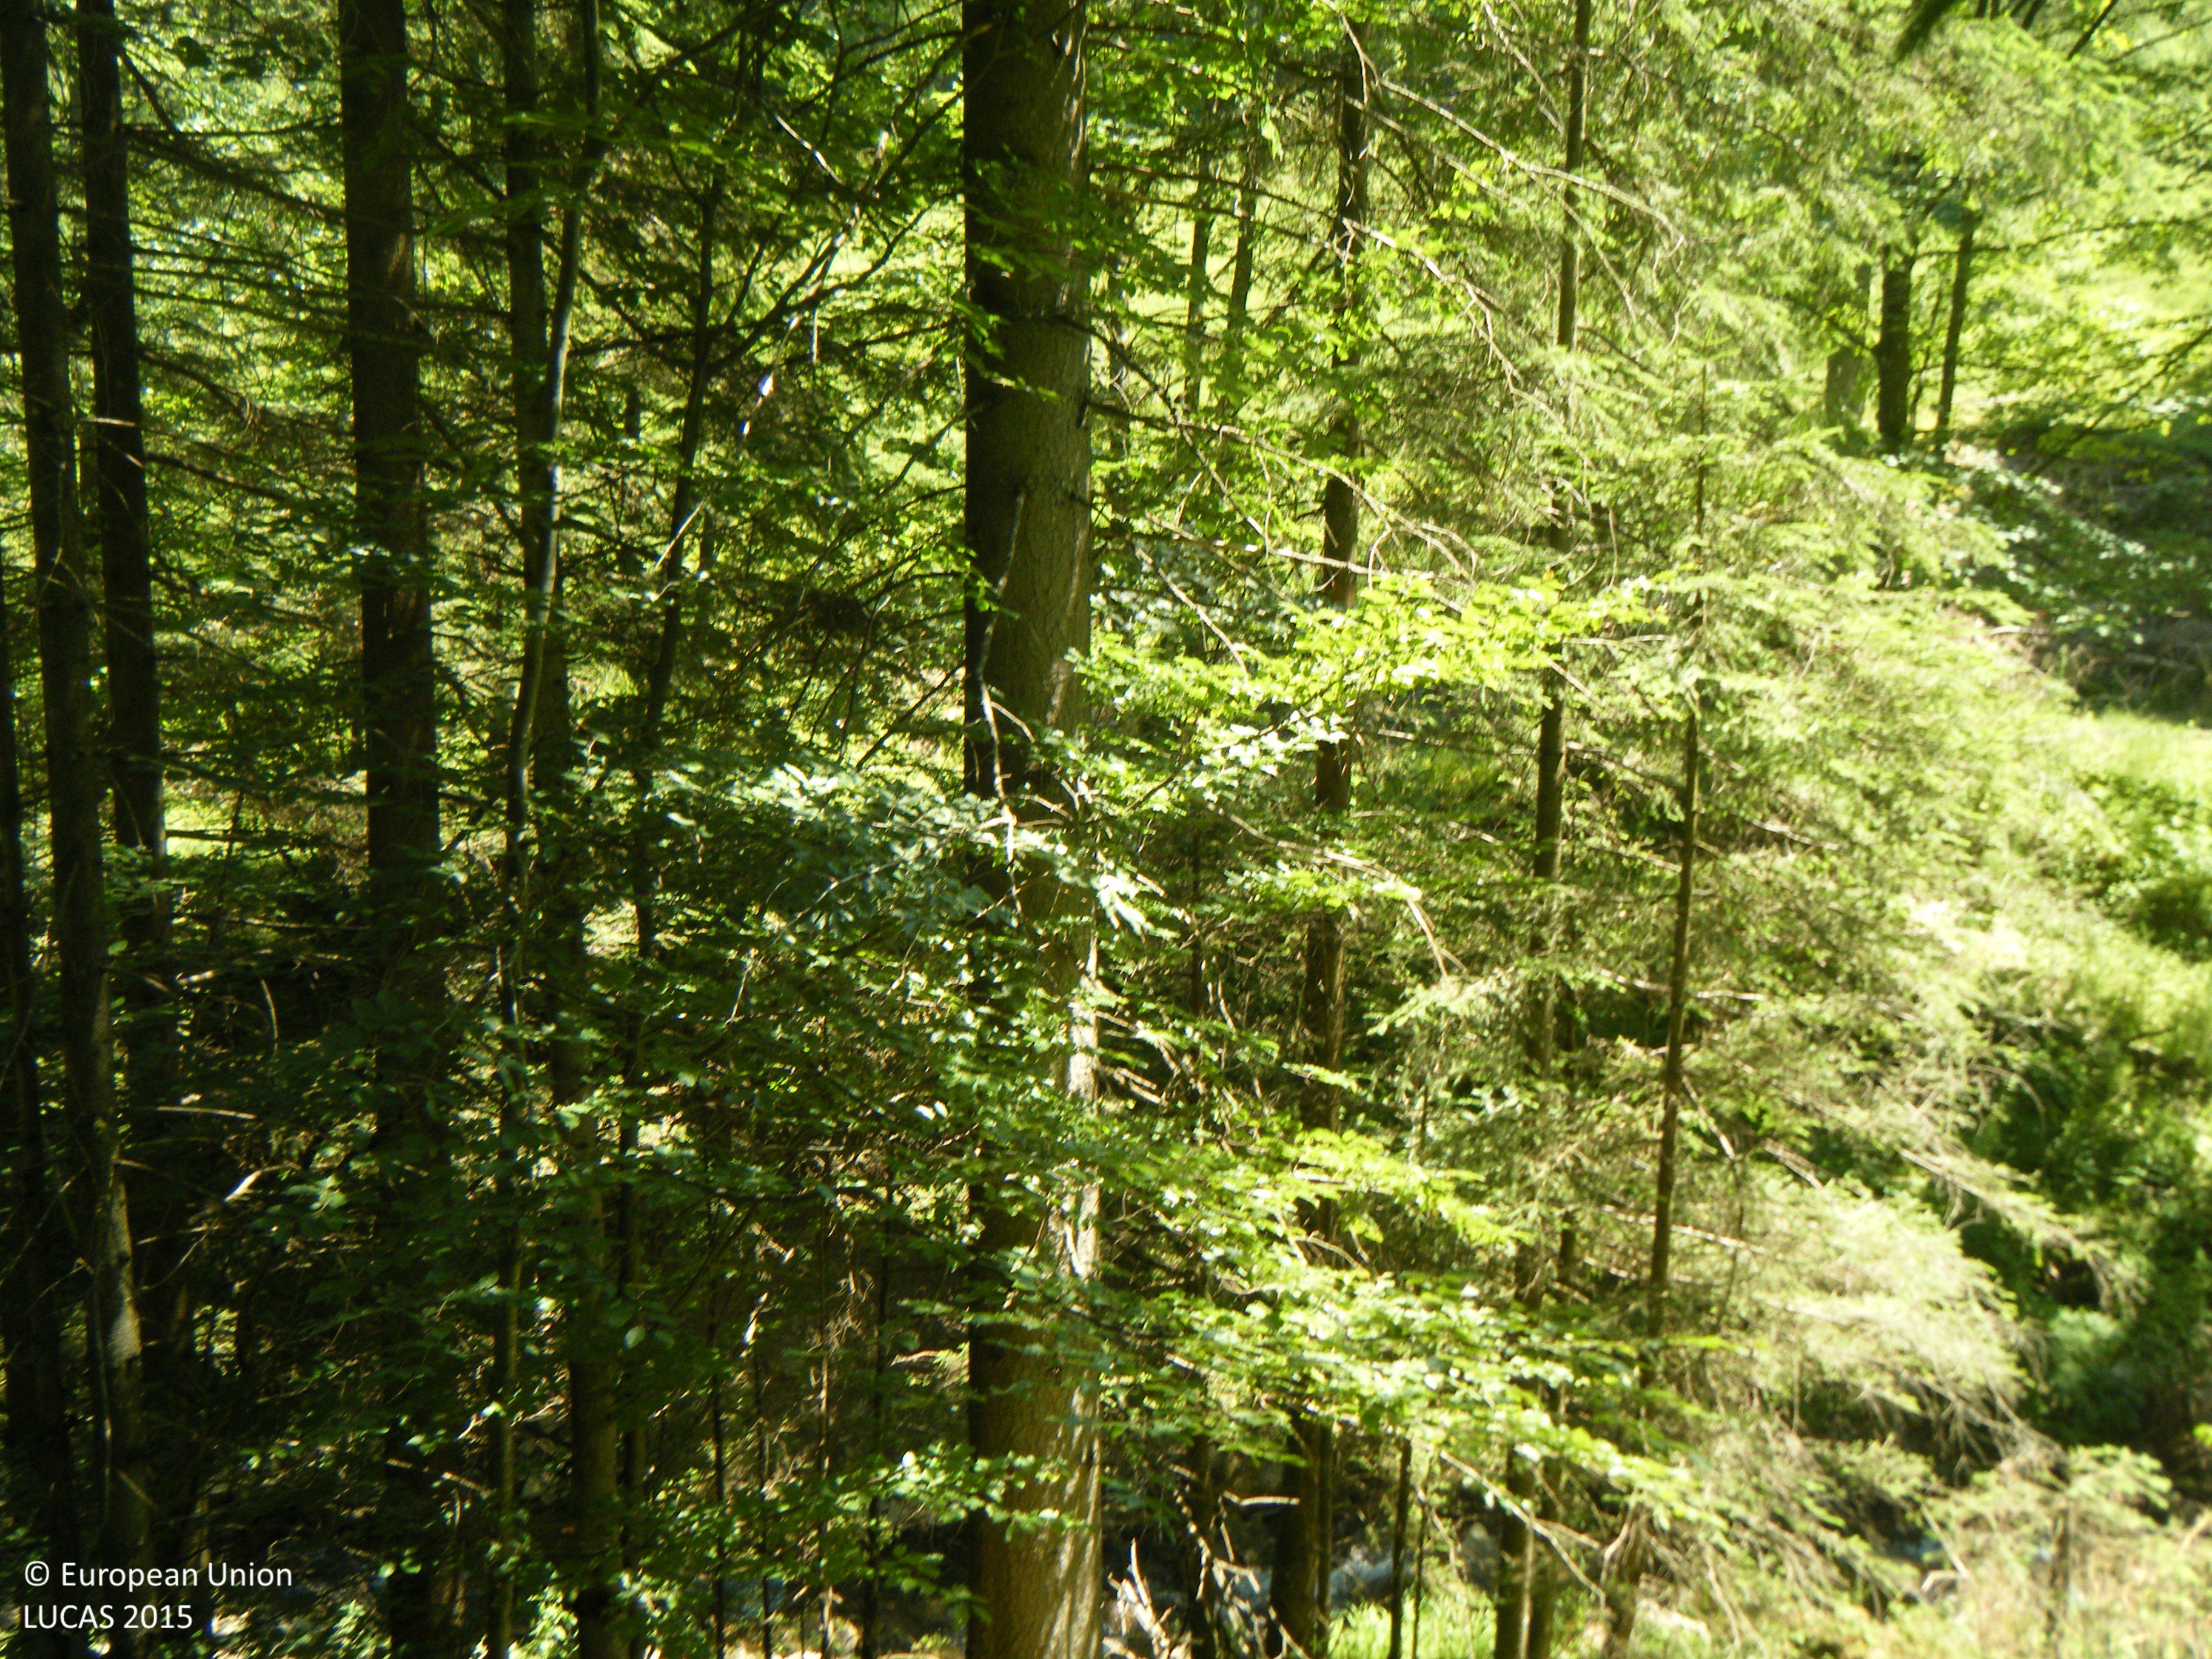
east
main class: Woodland
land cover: Spruce dominated mixed woodland
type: alpine coniferous forest
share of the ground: > 75 %
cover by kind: coniferous forest trees 60 %, broadleaved forest trees 25 %, herbaceous plants 15 %
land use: Forestry
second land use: Agriculture (excluding fallow land and kitchen gardens)
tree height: > 5 m
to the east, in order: Spruce dominated mixed woodland; Grassland without tree/shrub cover; Inland fresh running water; Spruce dominated mixed woodland; Tracks; Shrubland with sparse tree cover; Tracks; Grassland with sparse tree/shrub cover; Rivers and streams; Grassland with sparse tree/shrub cover; Tracks; Spruce dominated mixed woodland; Shrubland with sparse tree cover; Spruce dominated mixed woodland; Tracks; Spruce dominated coniferous woodland
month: July
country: AT
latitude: 47.7593
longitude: 13.3205
